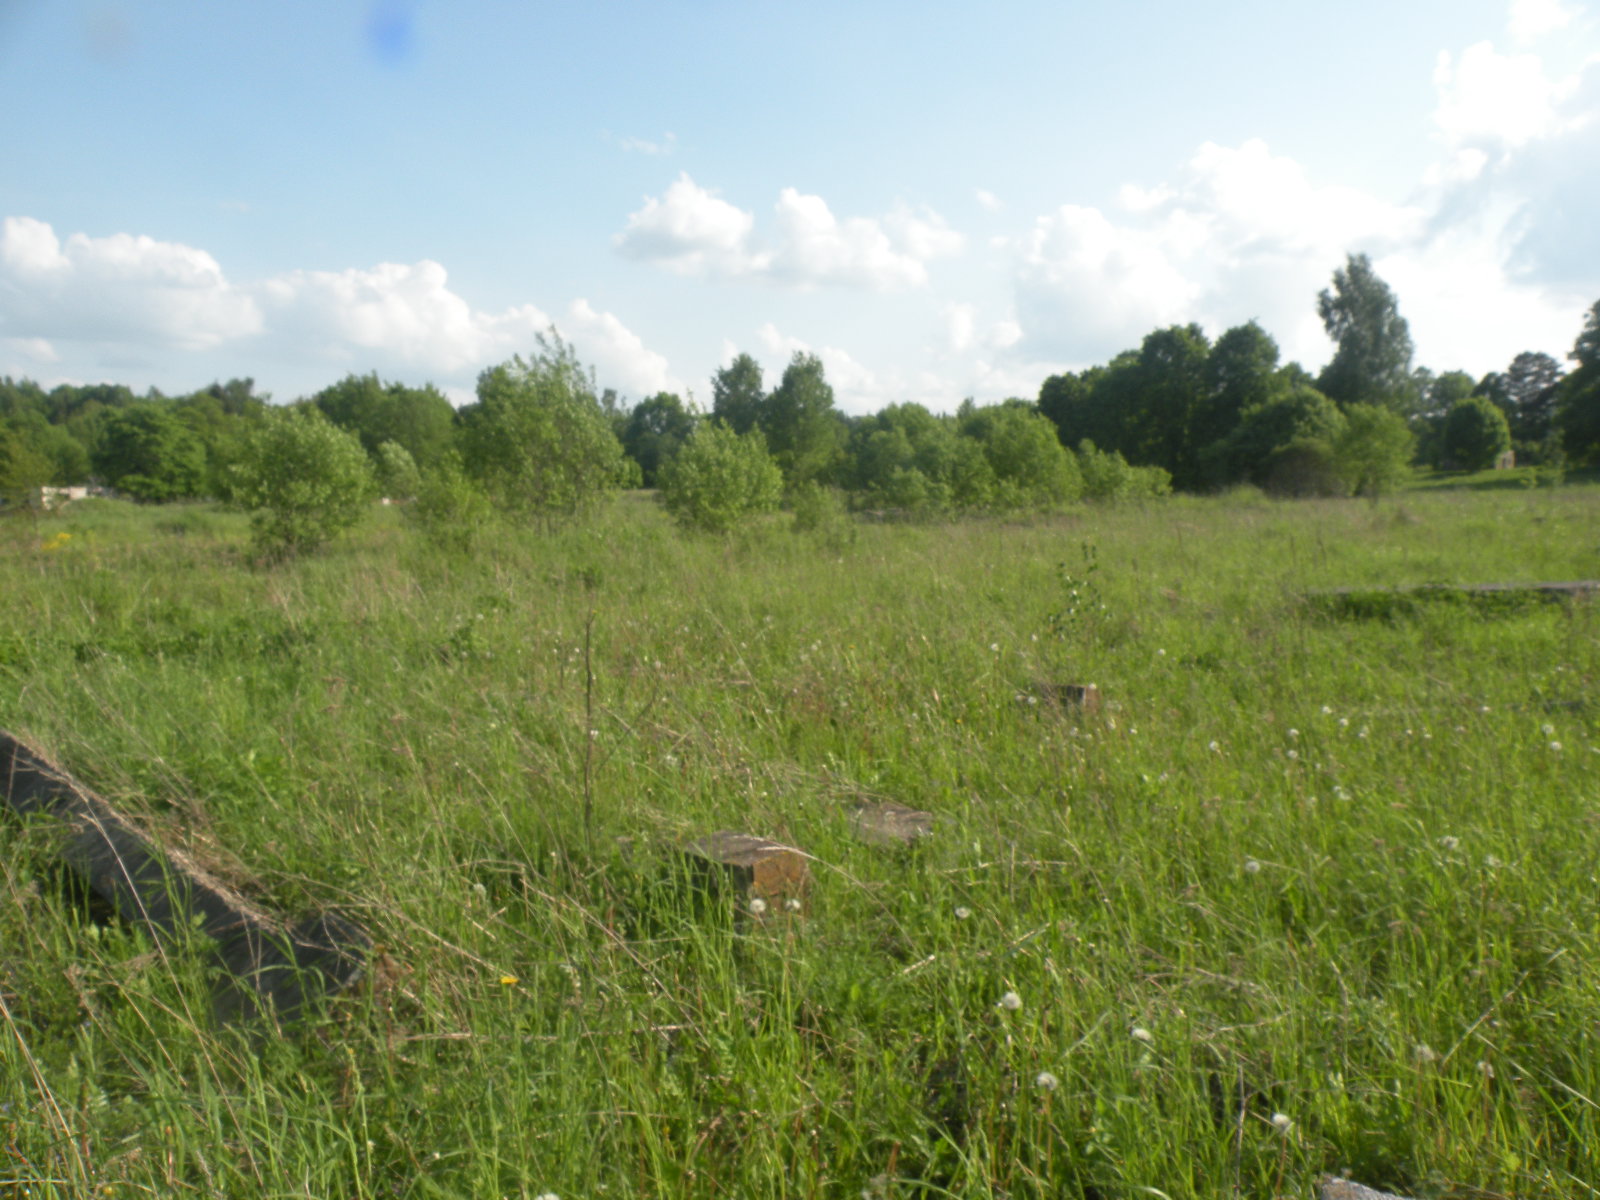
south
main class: Grassland
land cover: Spontaneously vegetated surfaces
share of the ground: > 75 %
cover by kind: herbaceous plants 95 %, shrubs 5 %
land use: Abandoned areas
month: May
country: LV
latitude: 55.9252
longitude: 26.1605
